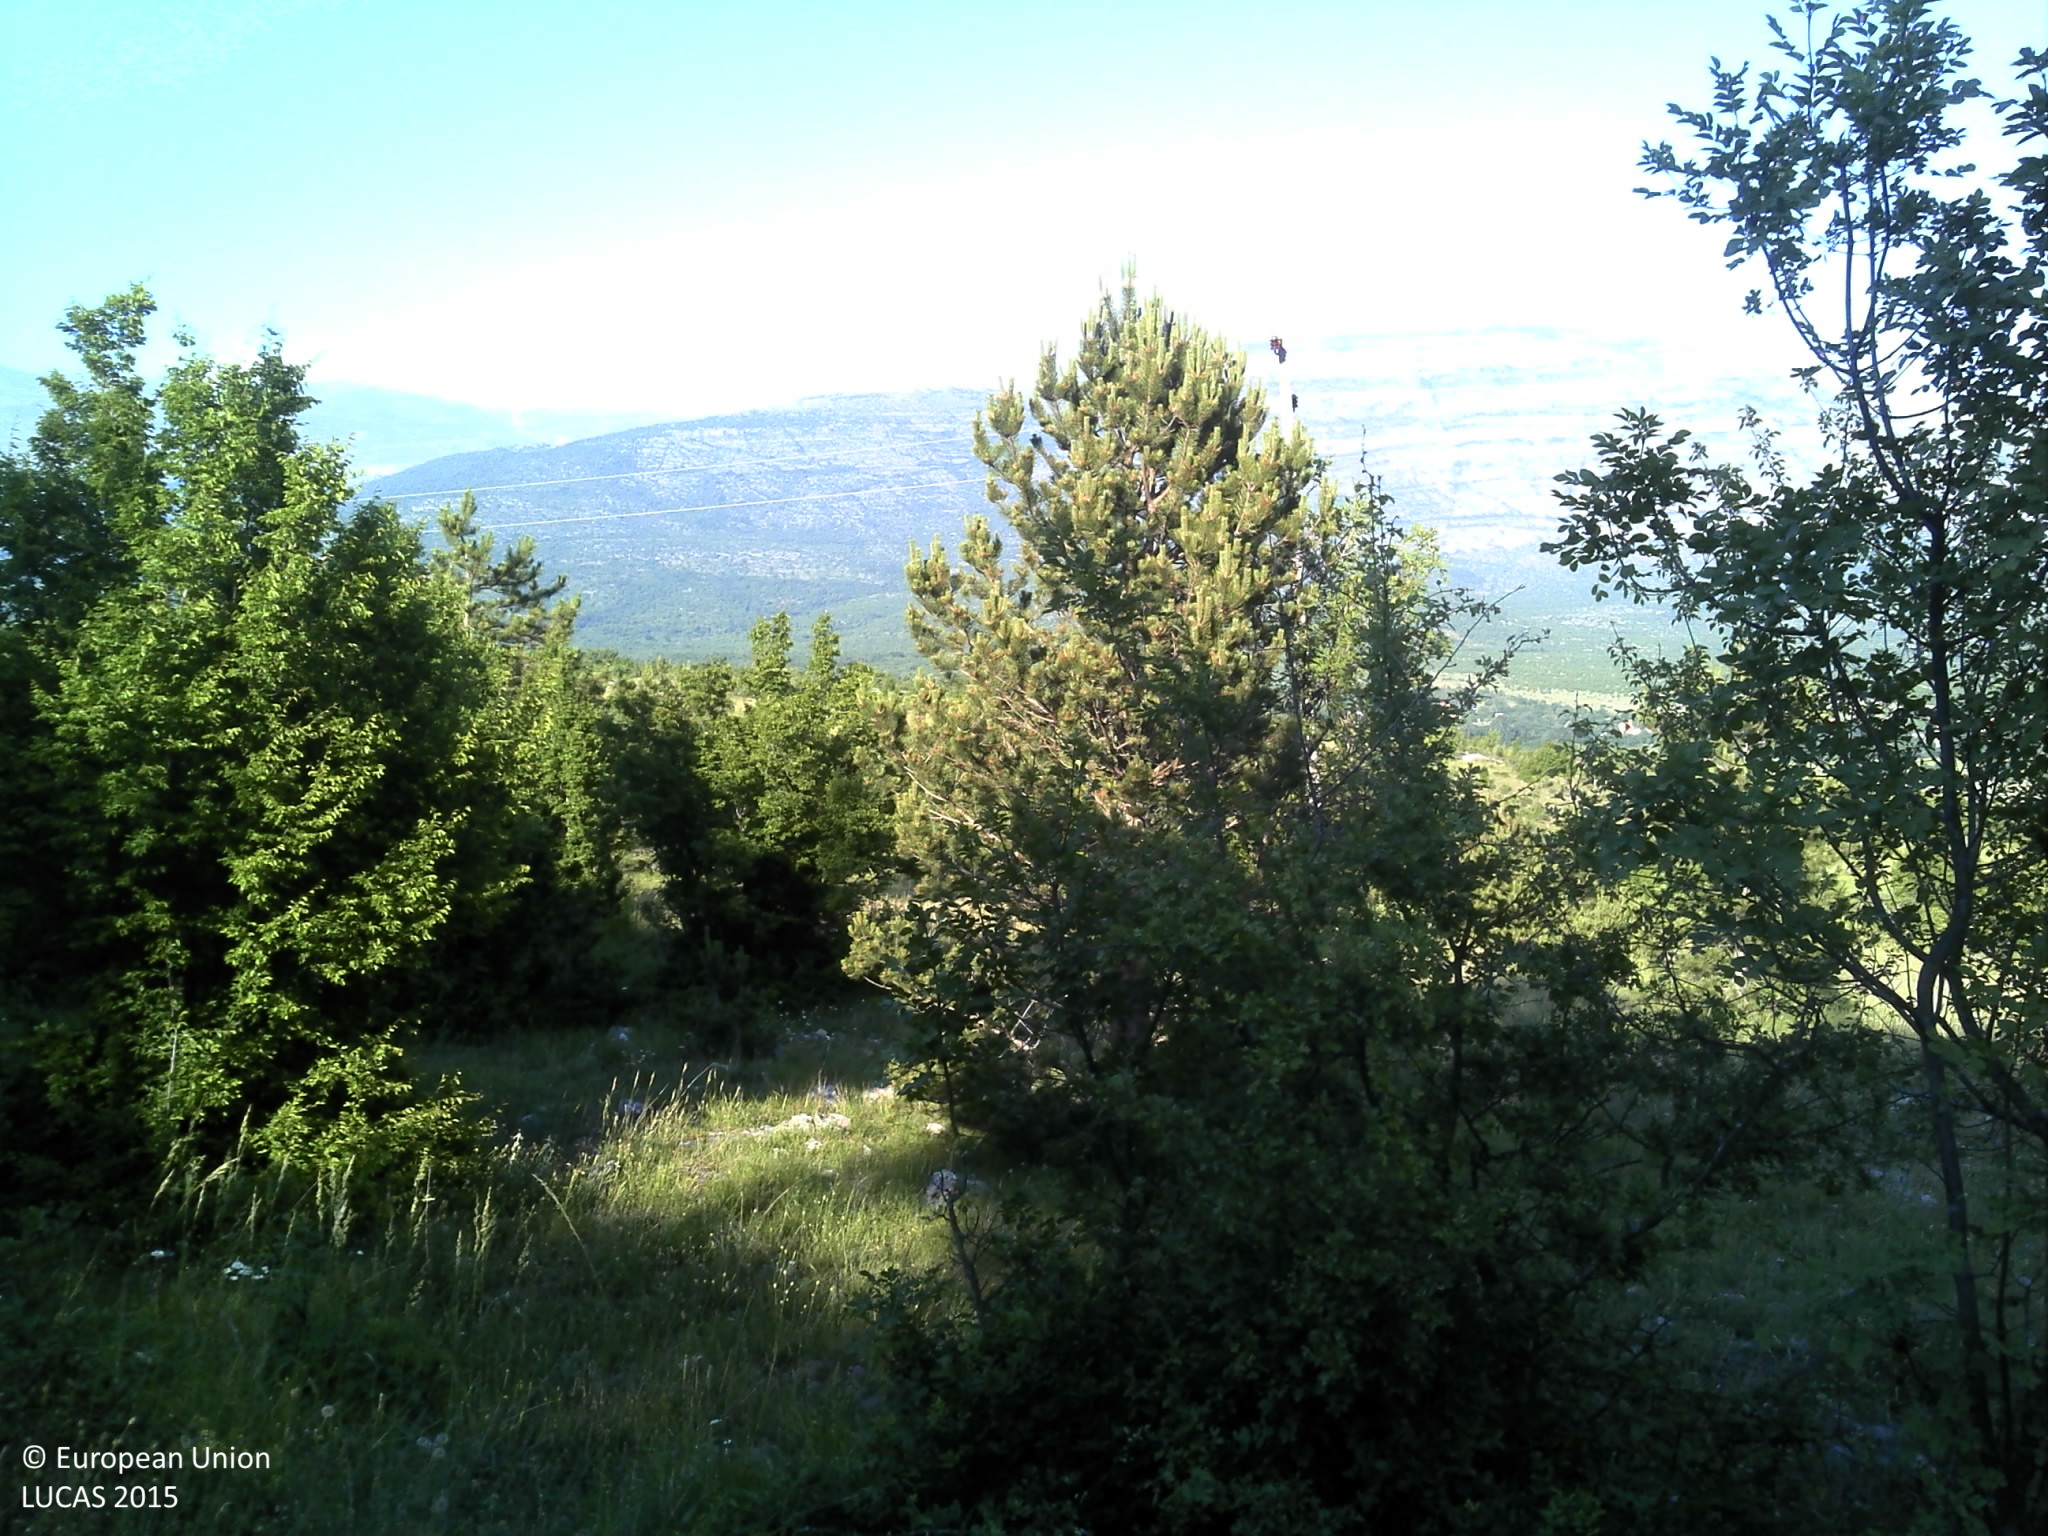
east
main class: Woodland
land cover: Pine dominated coniferous woodland
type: coniferous forest of the mediterranean region
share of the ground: > 75 %
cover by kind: coniferous forest trees 90 %, shrubs 5 %, herbaceous plants 5 %
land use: Forestry
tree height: > 5 m
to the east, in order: Paved roads, cycling and walking lanes; Pine dominated coniferous woodland; Paved roads, cycling and walking lanes; Shrubland with sparse tree cover; Electric lines; Grassland with sparse tree/shrub cover; Shrubland with sparse tree cover; Grassland with sparse tree/shrub cover; Shrubland with sparse tree cover; Tracks; Grassland with sparse tree/shrub cover
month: June
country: HR
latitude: 43.9713
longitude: 16.4120
